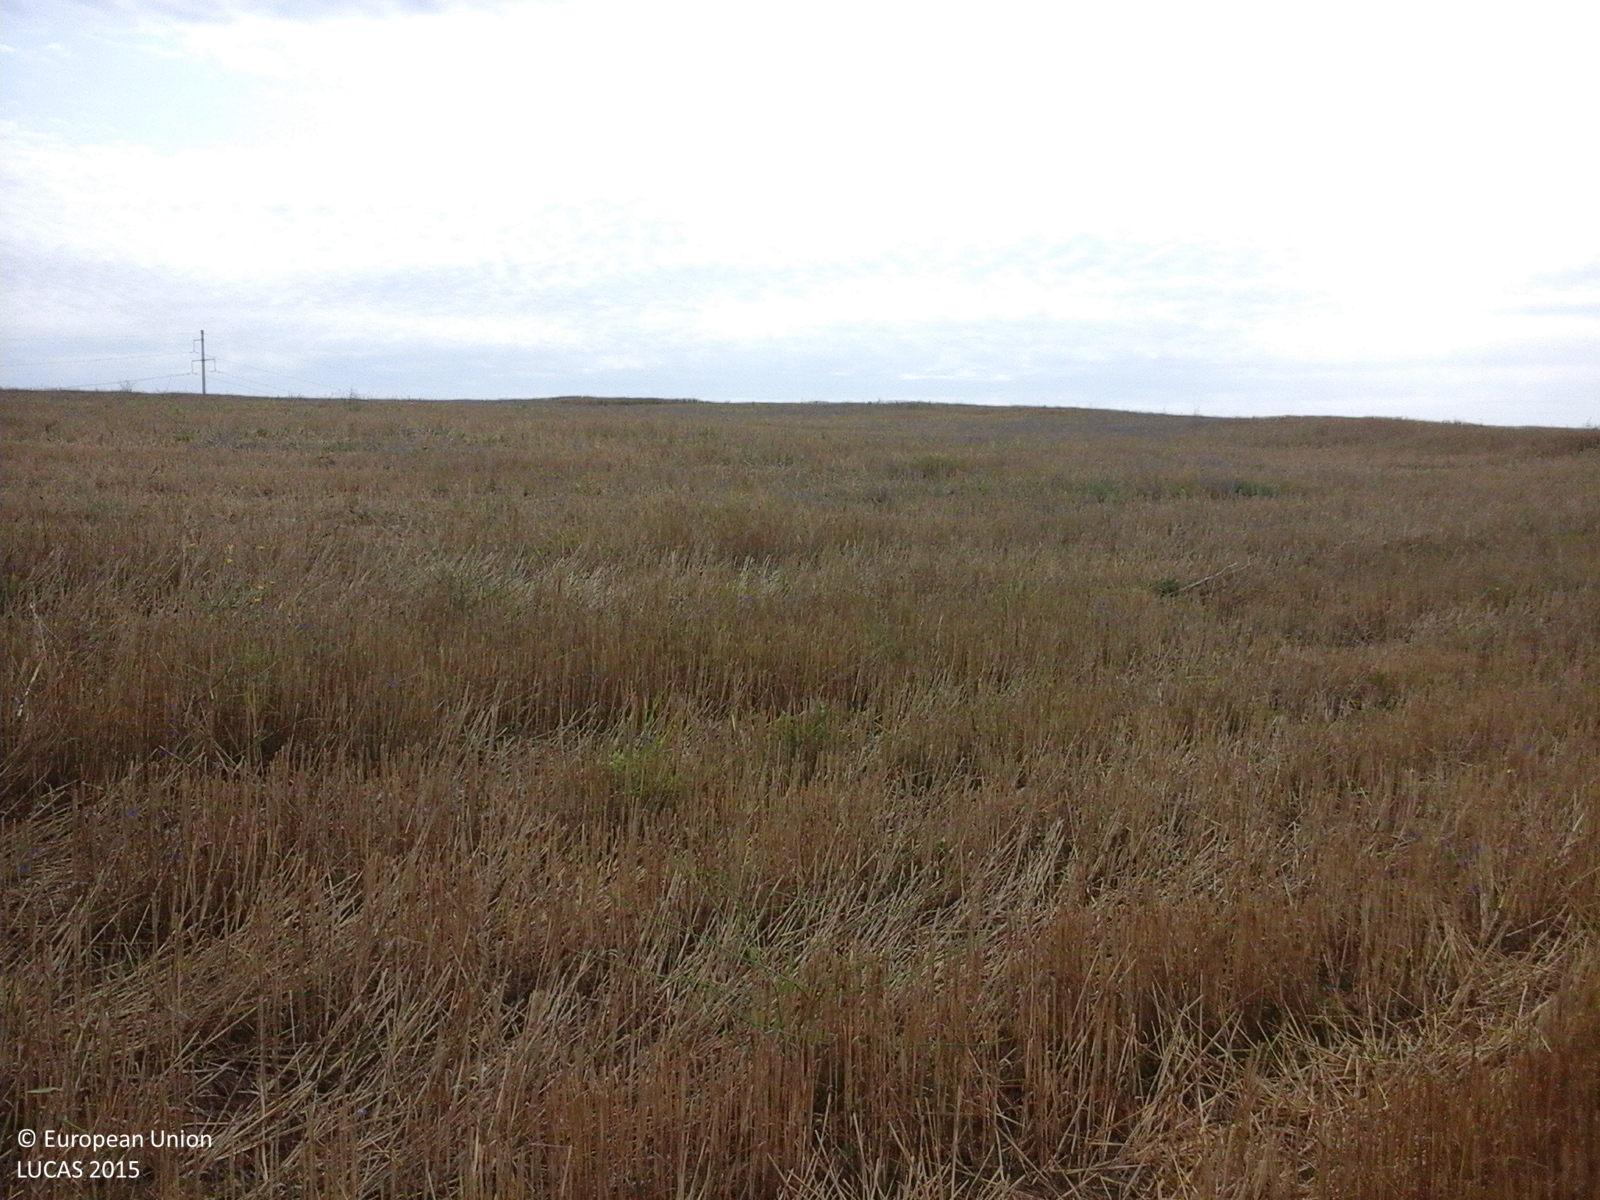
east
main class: Cropland
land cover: Common wheat
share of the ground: > 75 %
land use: Agriculture (excluding fallow land and kitchen gardens)
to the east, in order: Common wheat; Grass margins; Tracks; Grass margins; Lucerne
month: August
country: RO
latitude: 44.0614
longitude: 27.7343
